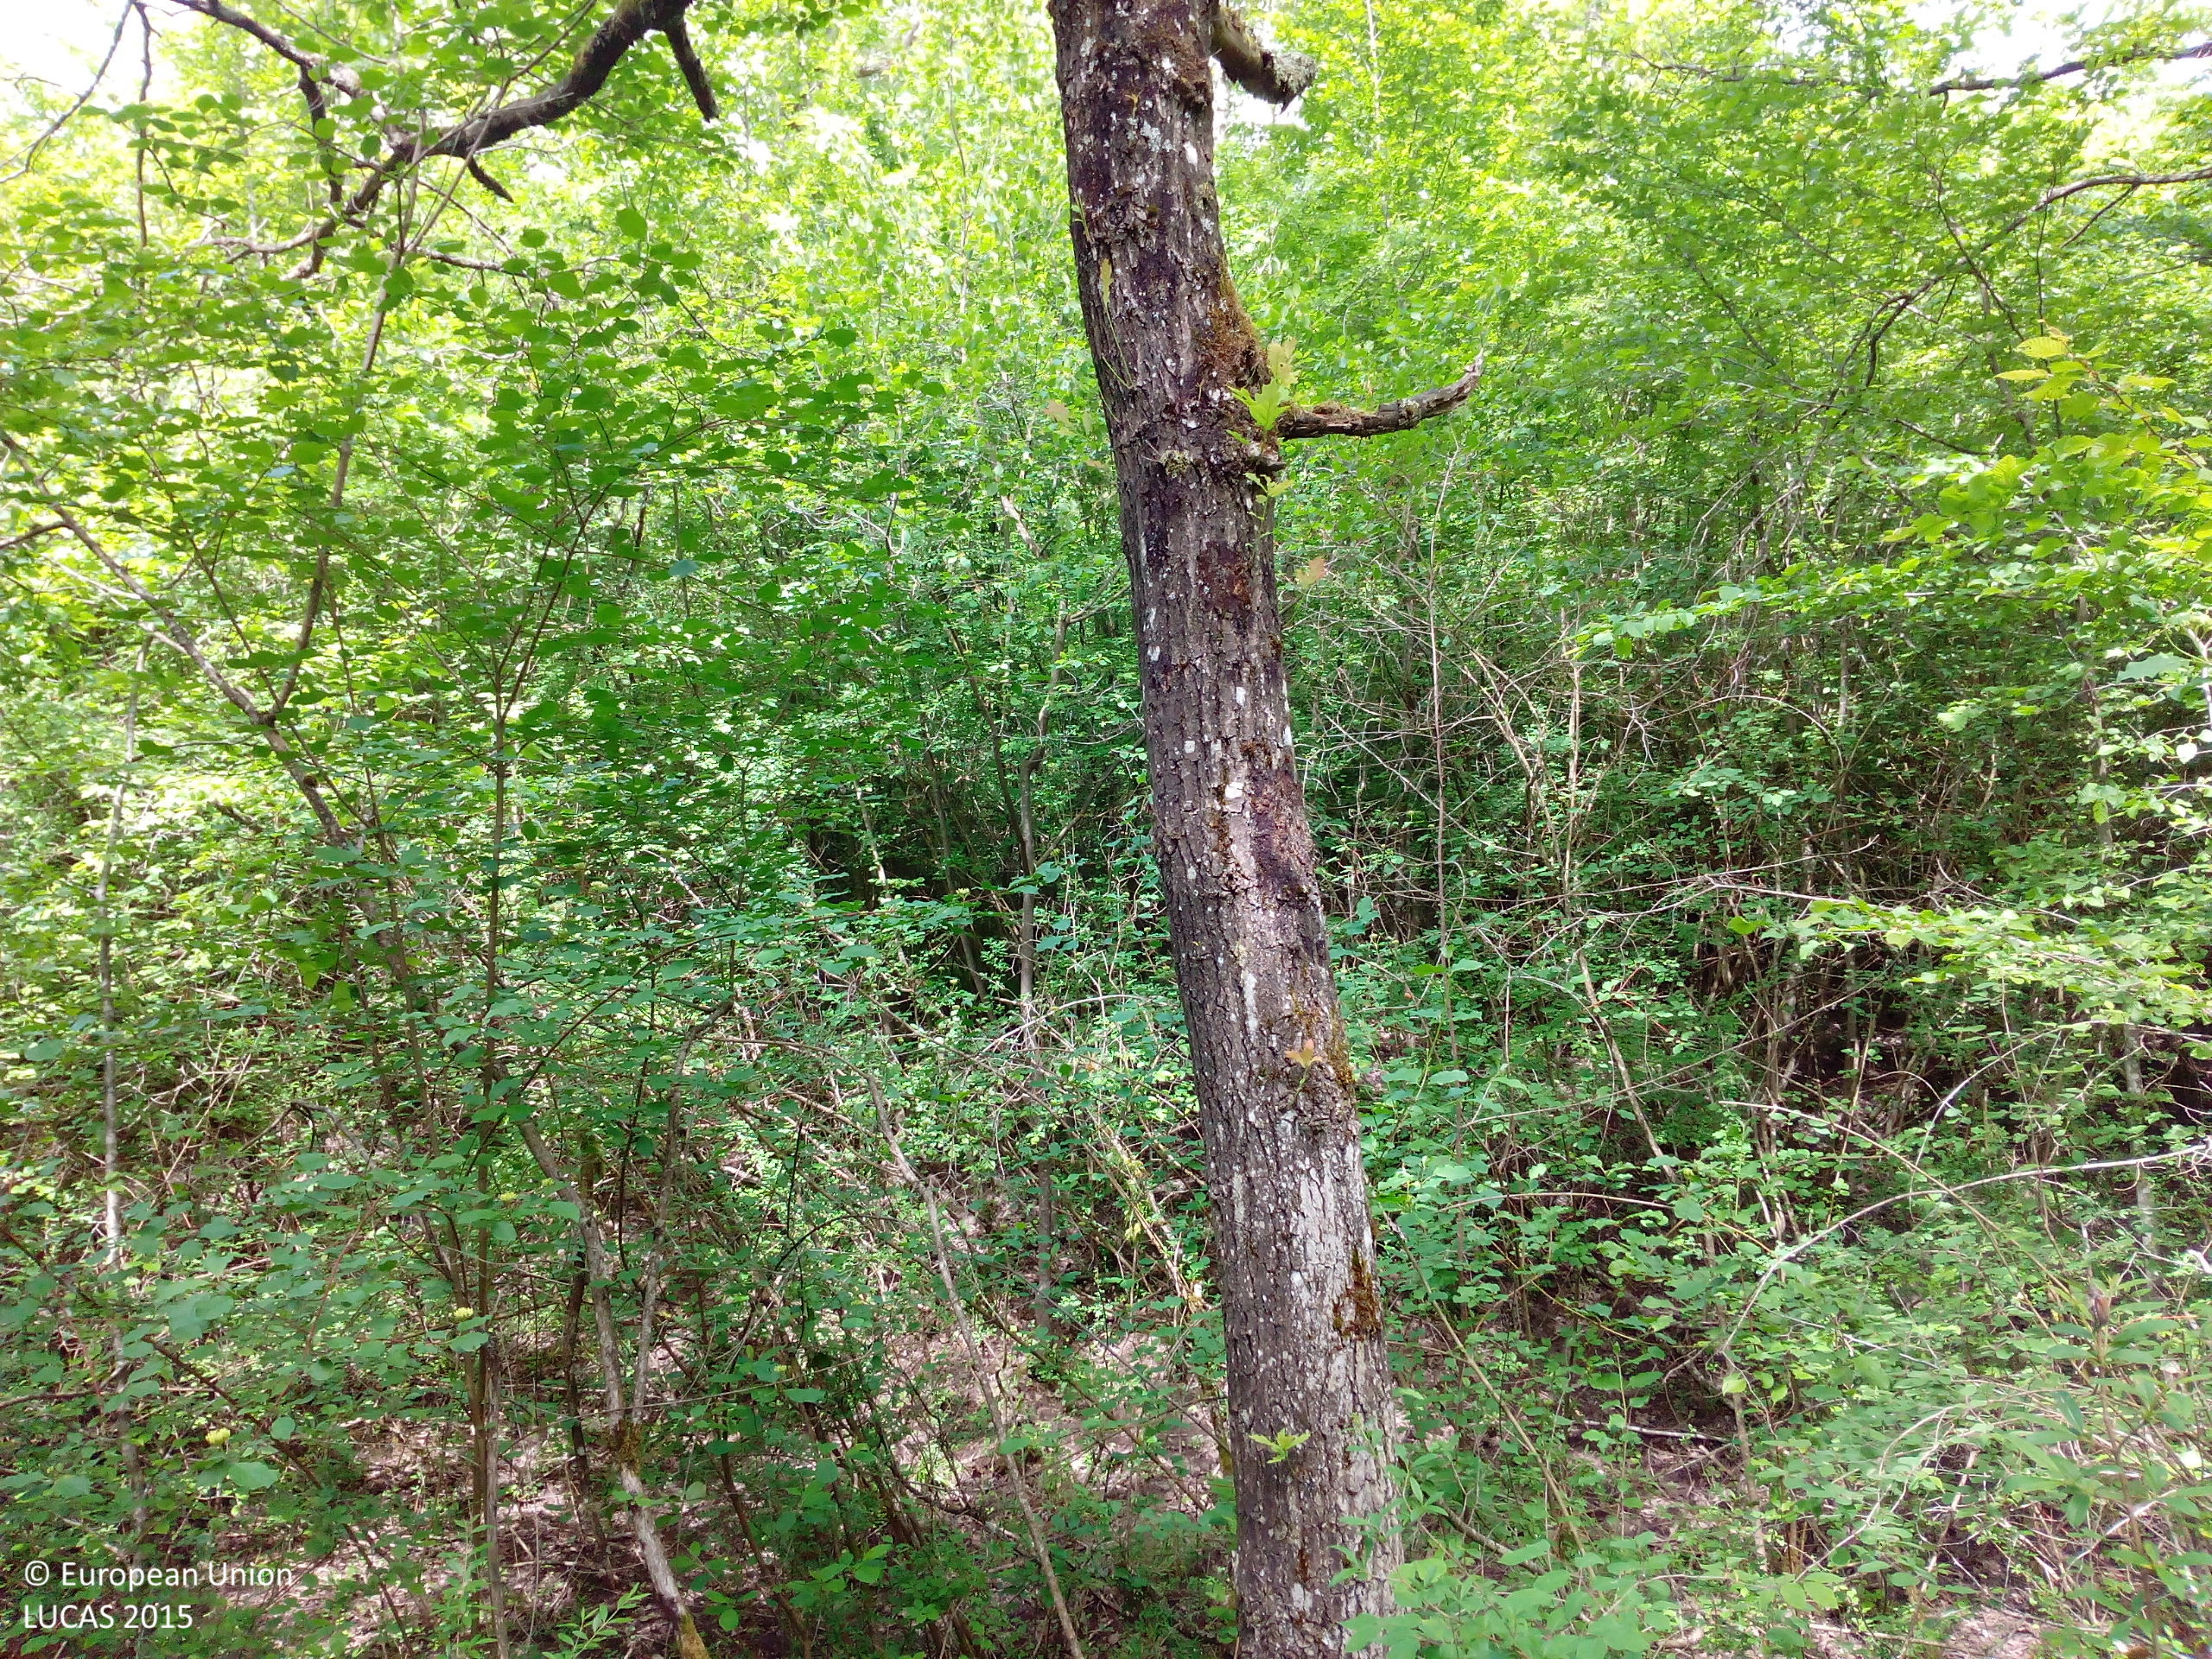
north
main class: Woodland
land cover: Broadleaved woodland
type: floodplain forest
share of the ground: > 75 %
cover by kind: broadleaved forest trees 85 %, shrubs 10 %, herbaceous plants 5 %
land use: Forestry
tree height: > 5 m
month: May
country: DE
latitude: 47.9455
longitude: 7.6047
